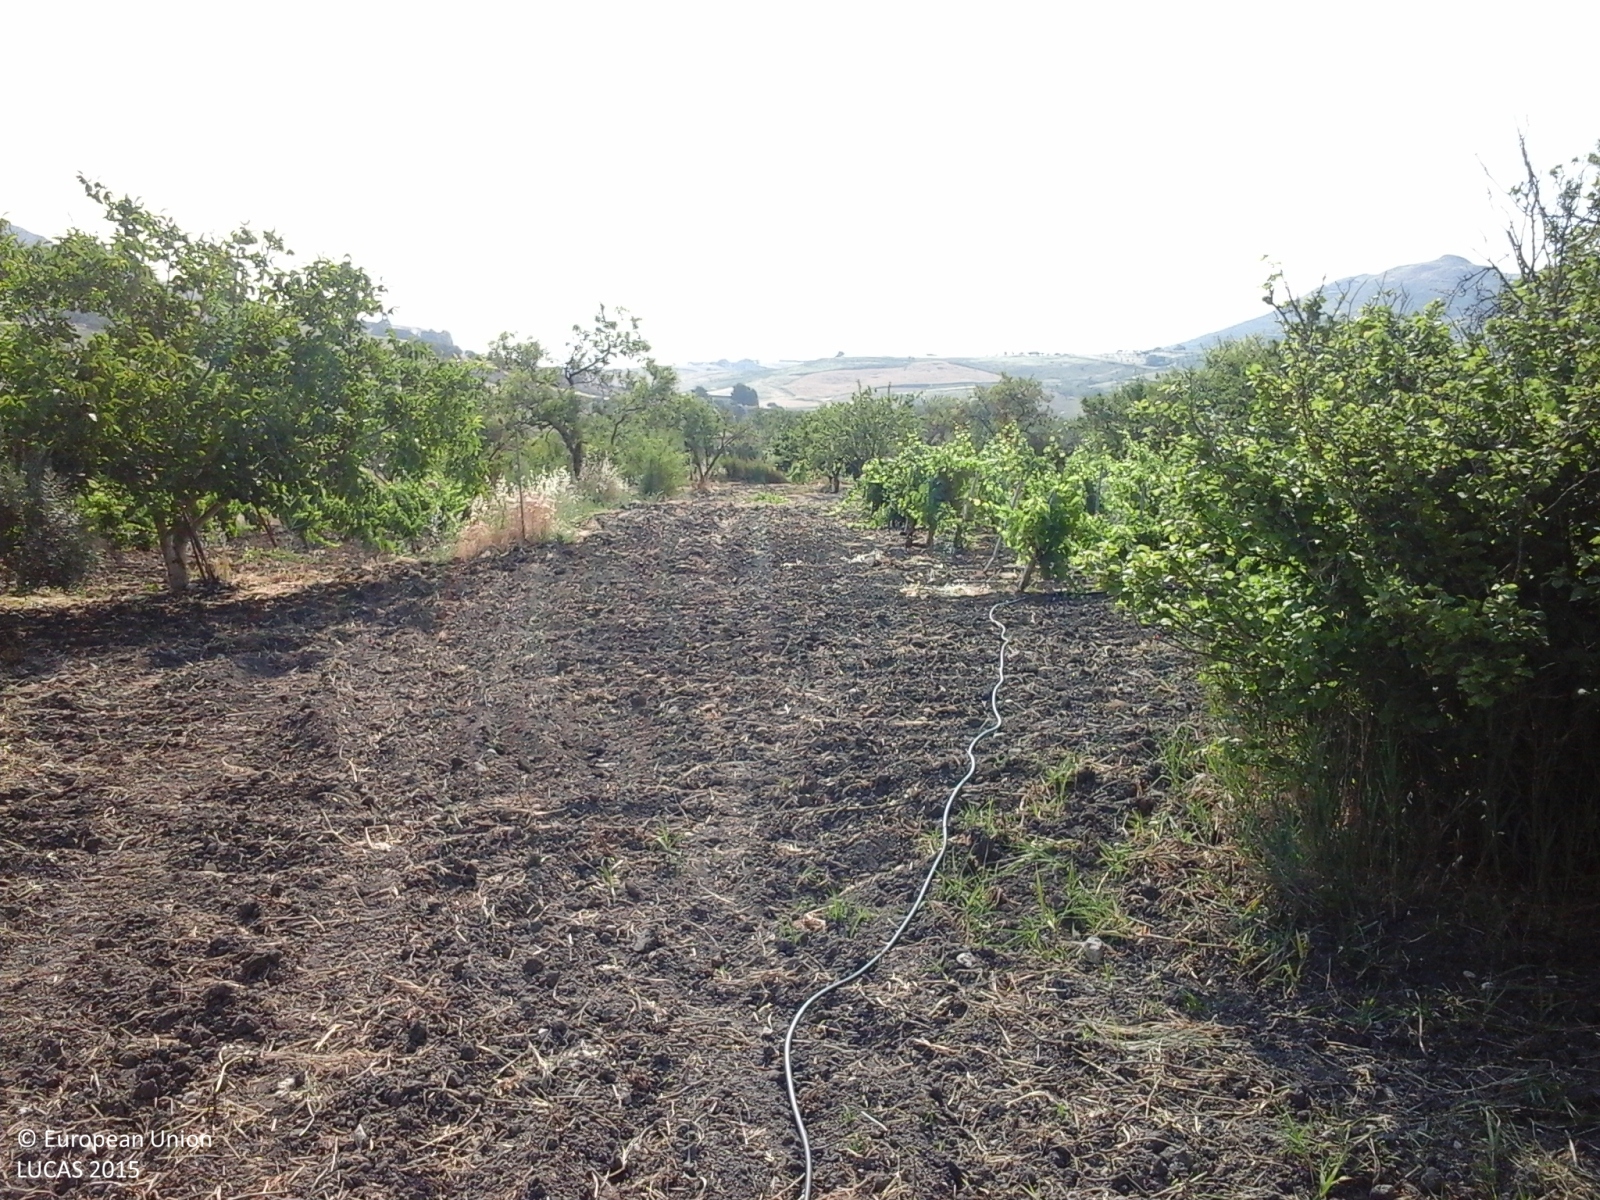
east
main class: Cropland
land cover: Olive groves
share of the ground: > 75 %
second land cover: Other bare soil
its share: > 75 %
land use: Agriculture (excluding fallow land and kitchen gardens)
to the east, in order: Olive groves; Other bare soil; Spontaneously vegetated surfaces; Inland fresh running water; Other bare soil; Nuts trees; Grass margins; Durum wheat; Grassland without tree/shrub cover; Inland fresh running water; Grassland without tree/shrub cover; Spontaneously vegetated surfaces
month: June
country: IT
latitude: 37.3748
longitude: 13.4850
